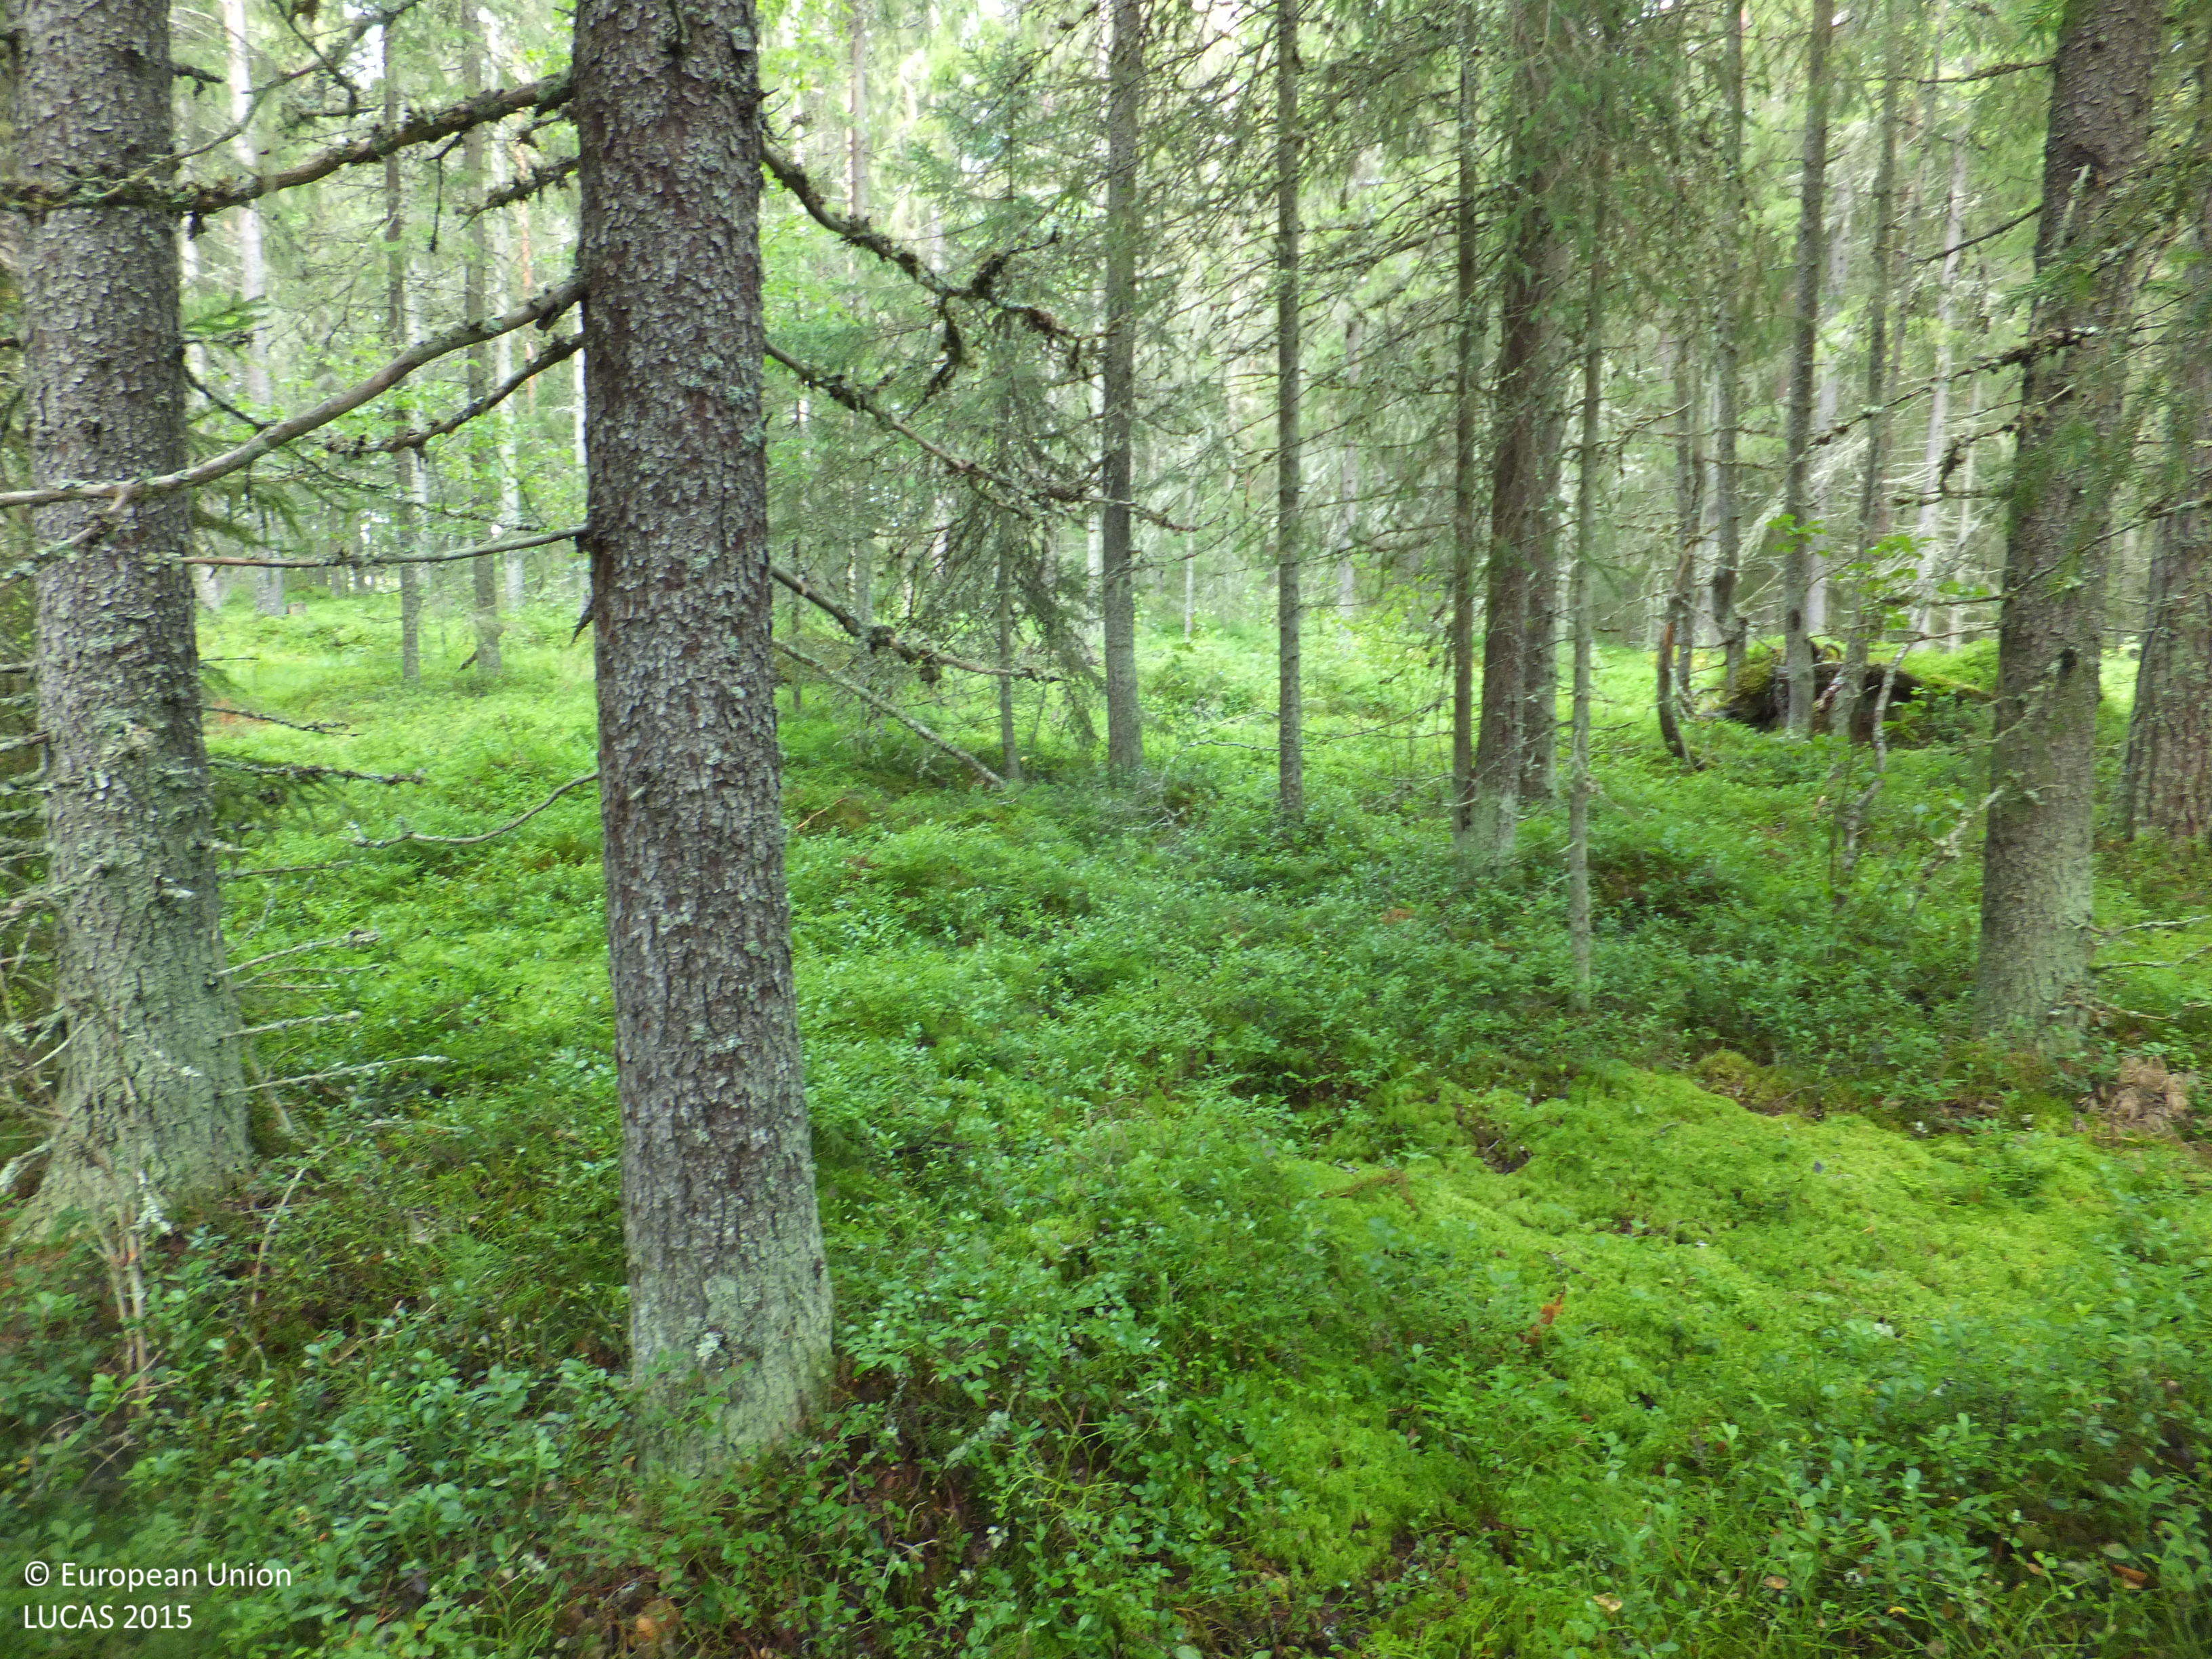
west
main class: Woodland
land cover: Other coniferous woodland
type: boreal forest
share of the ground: > 75 %
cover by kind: coniferous forest trees 85 %, broadleaved forest trees 5 %, shrubs 5 %, lichens and mosses 5 %
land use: Forestry
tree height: > 5 m
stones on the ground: < 10 %
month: July
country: FI
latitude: 63.1565
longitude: 21.9734
